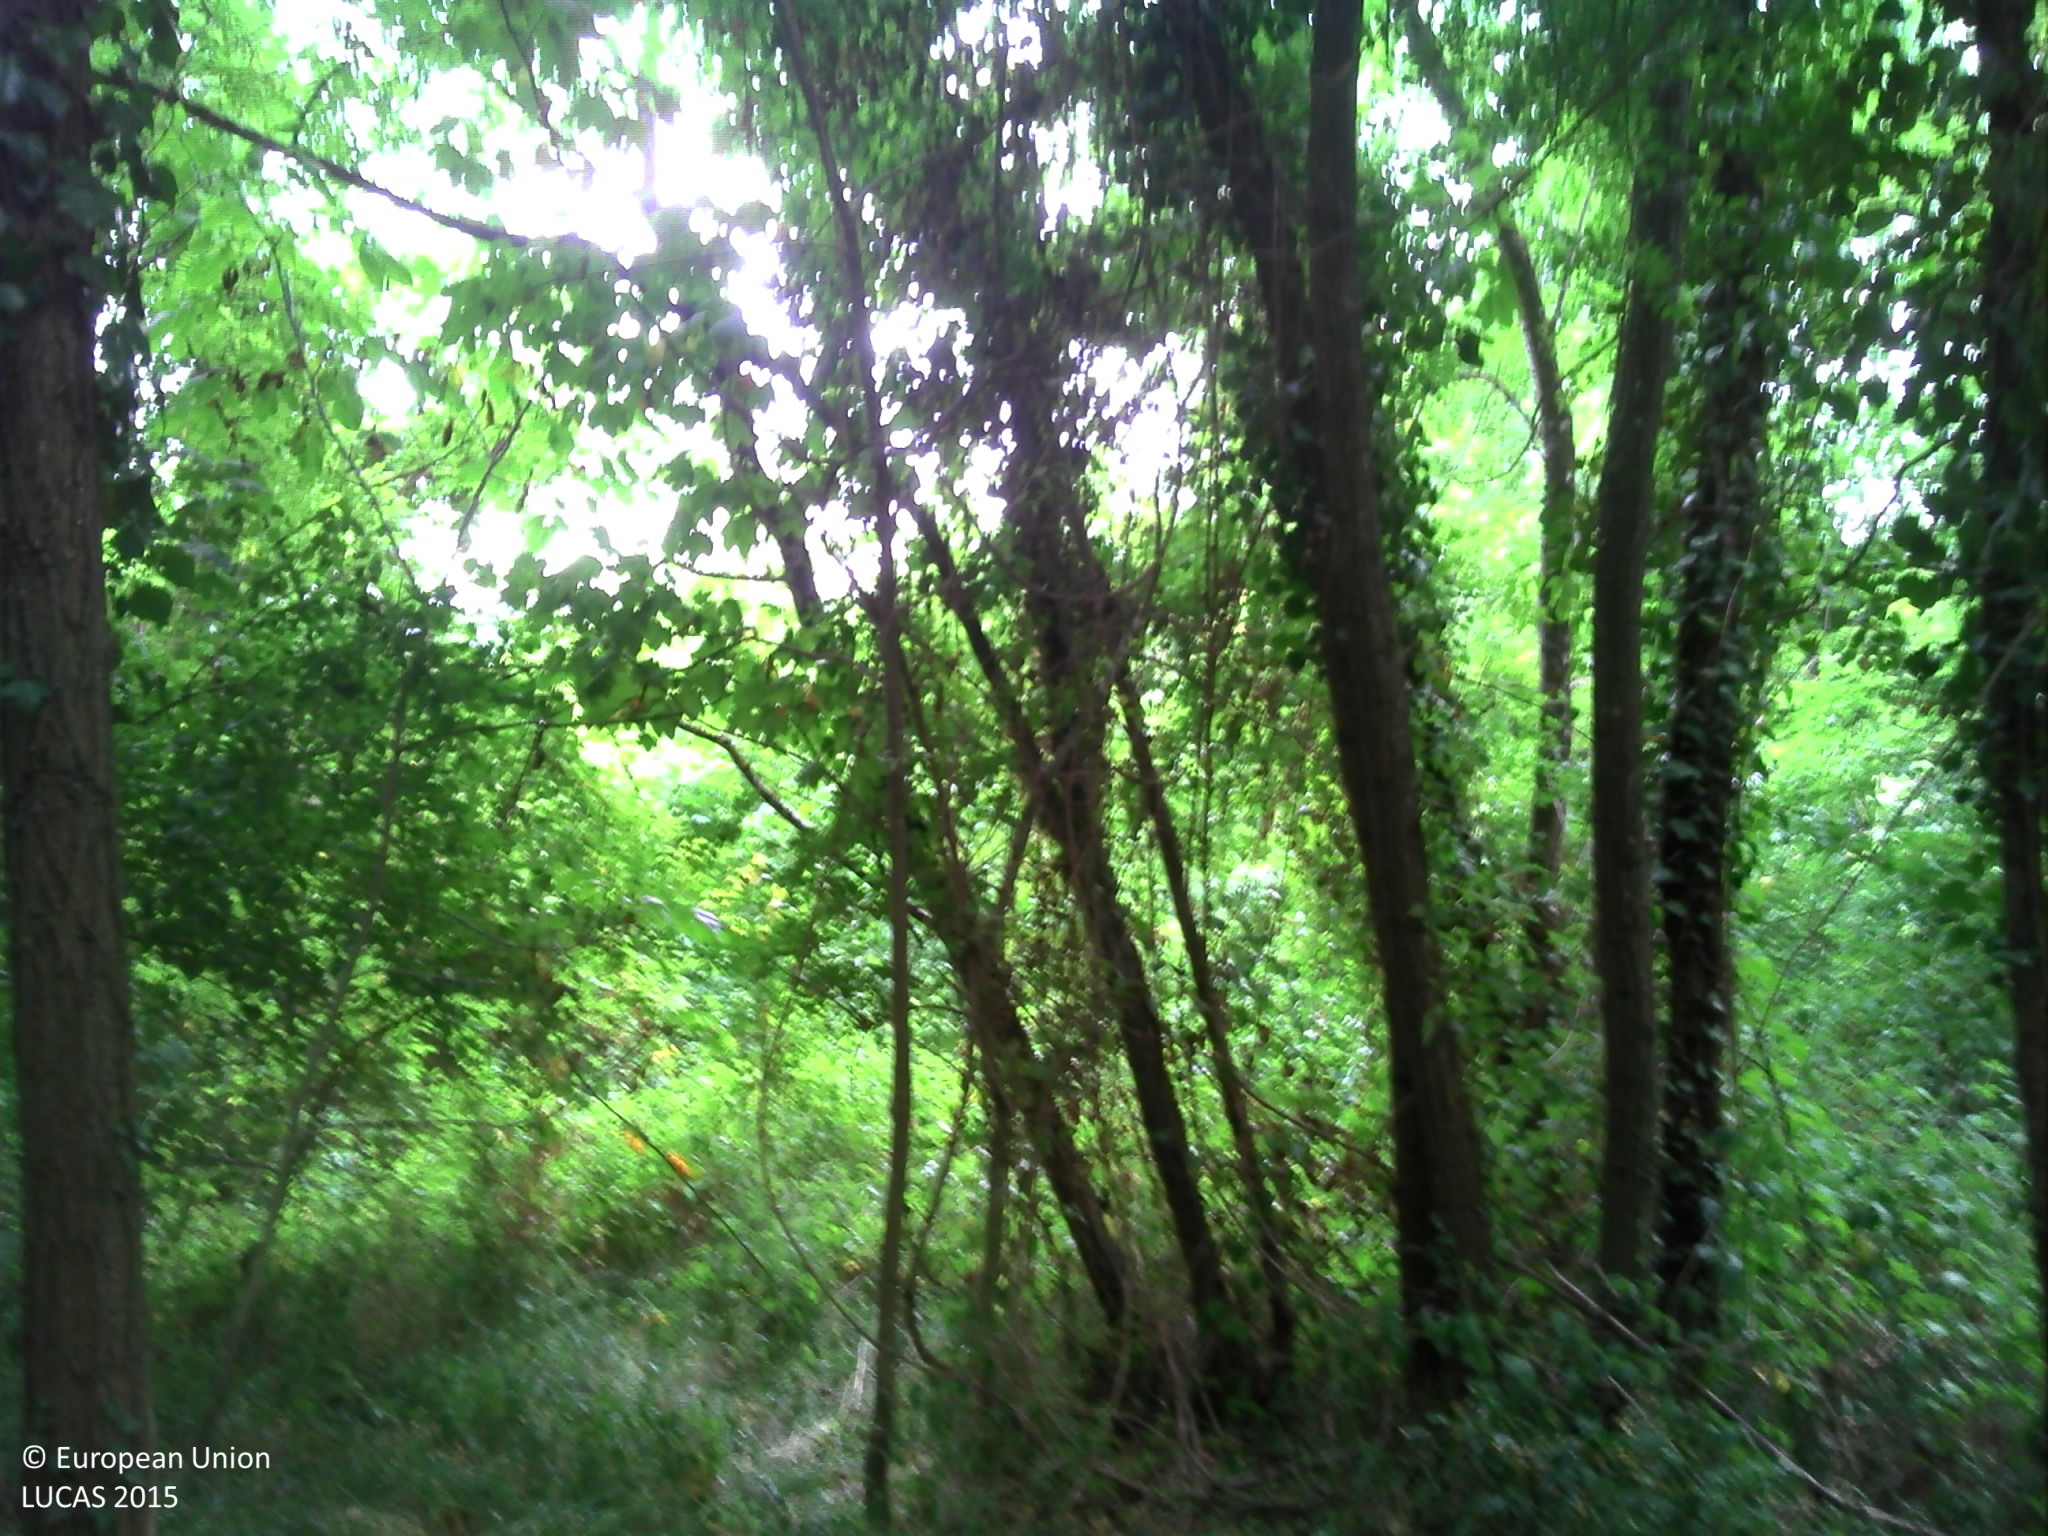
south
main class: Woodland
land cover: Broadleaved woodland
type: mesophytic deciduous forest
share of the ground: > 75 %
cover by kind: broadleaved forest trees 75 %, shrubs 10 %, herbaceous plants 10 %, lichens and mosses 5 %
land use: Forestry
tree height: > 5 m
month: July
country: FR
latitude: 47.3110
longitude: 0.3614
